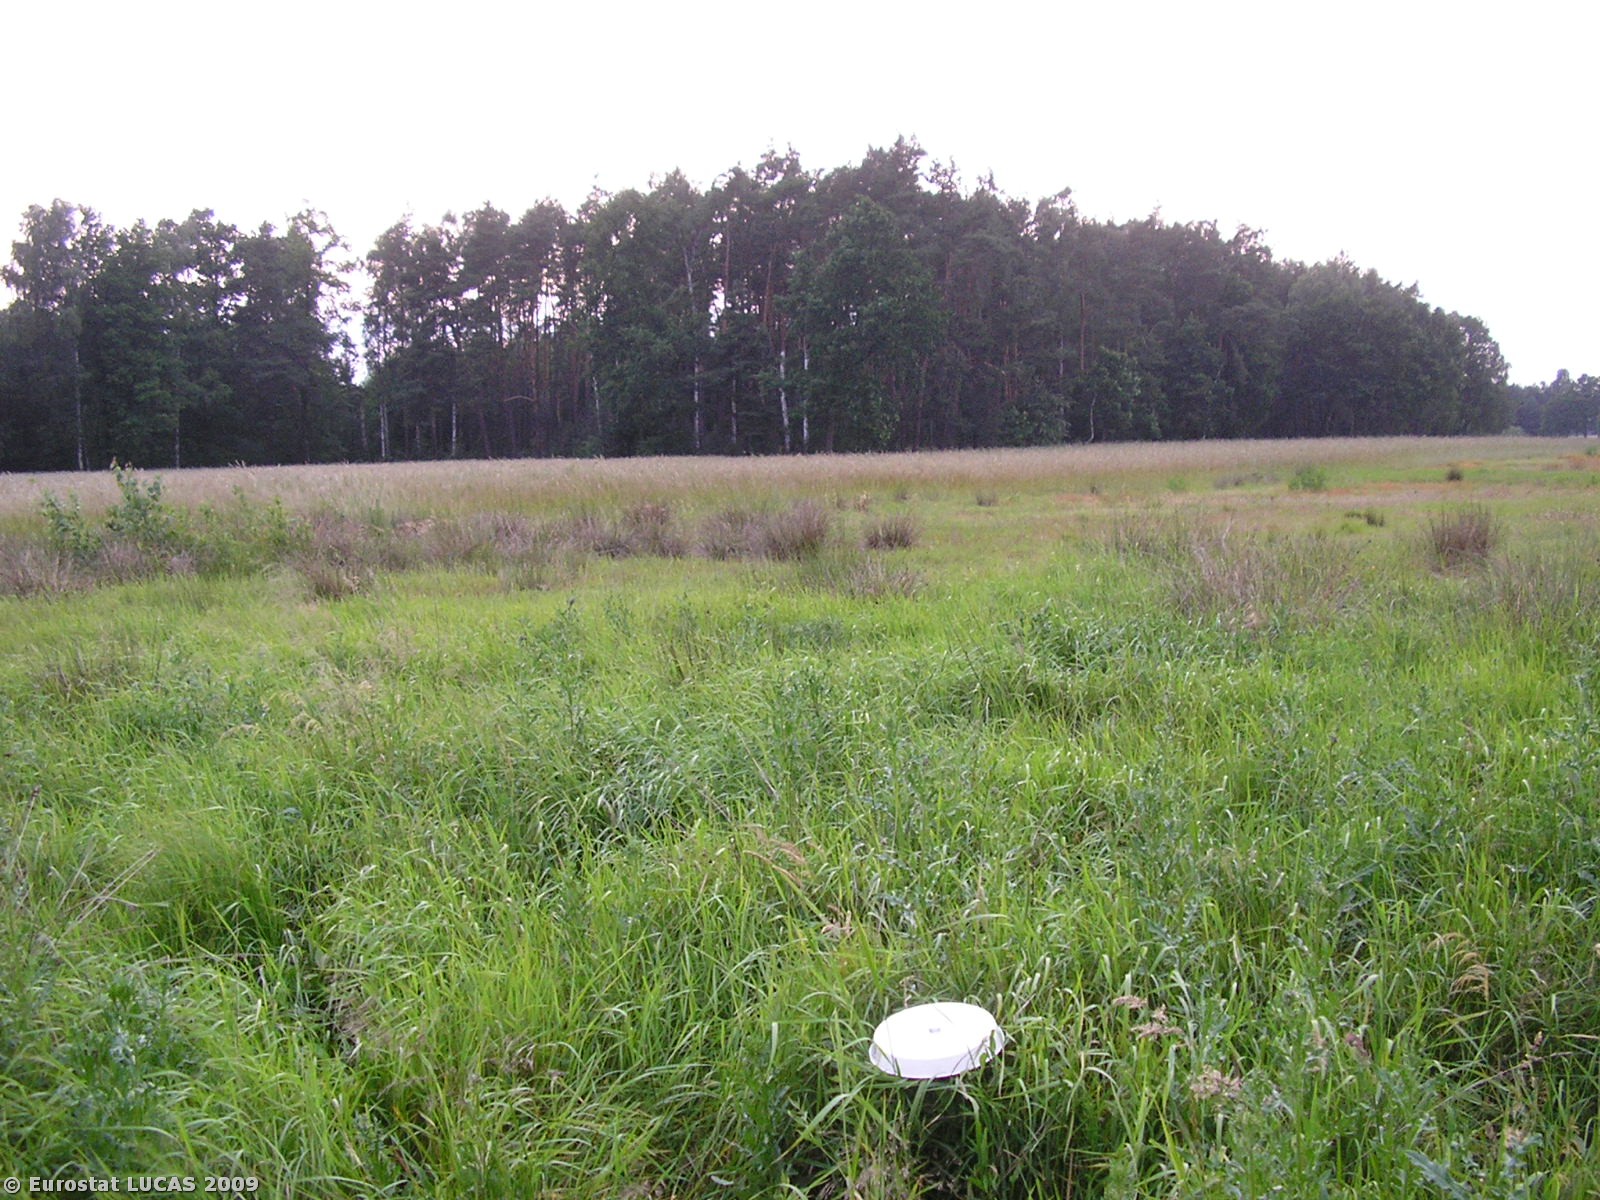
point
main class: Grassland
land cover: Grassland without tree/shrub cover
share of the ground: > 75 %
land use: Agriculture (excluding fallow land and kitchen gardens)
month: June
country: PL
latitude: 51.4304
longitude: 18.3753
